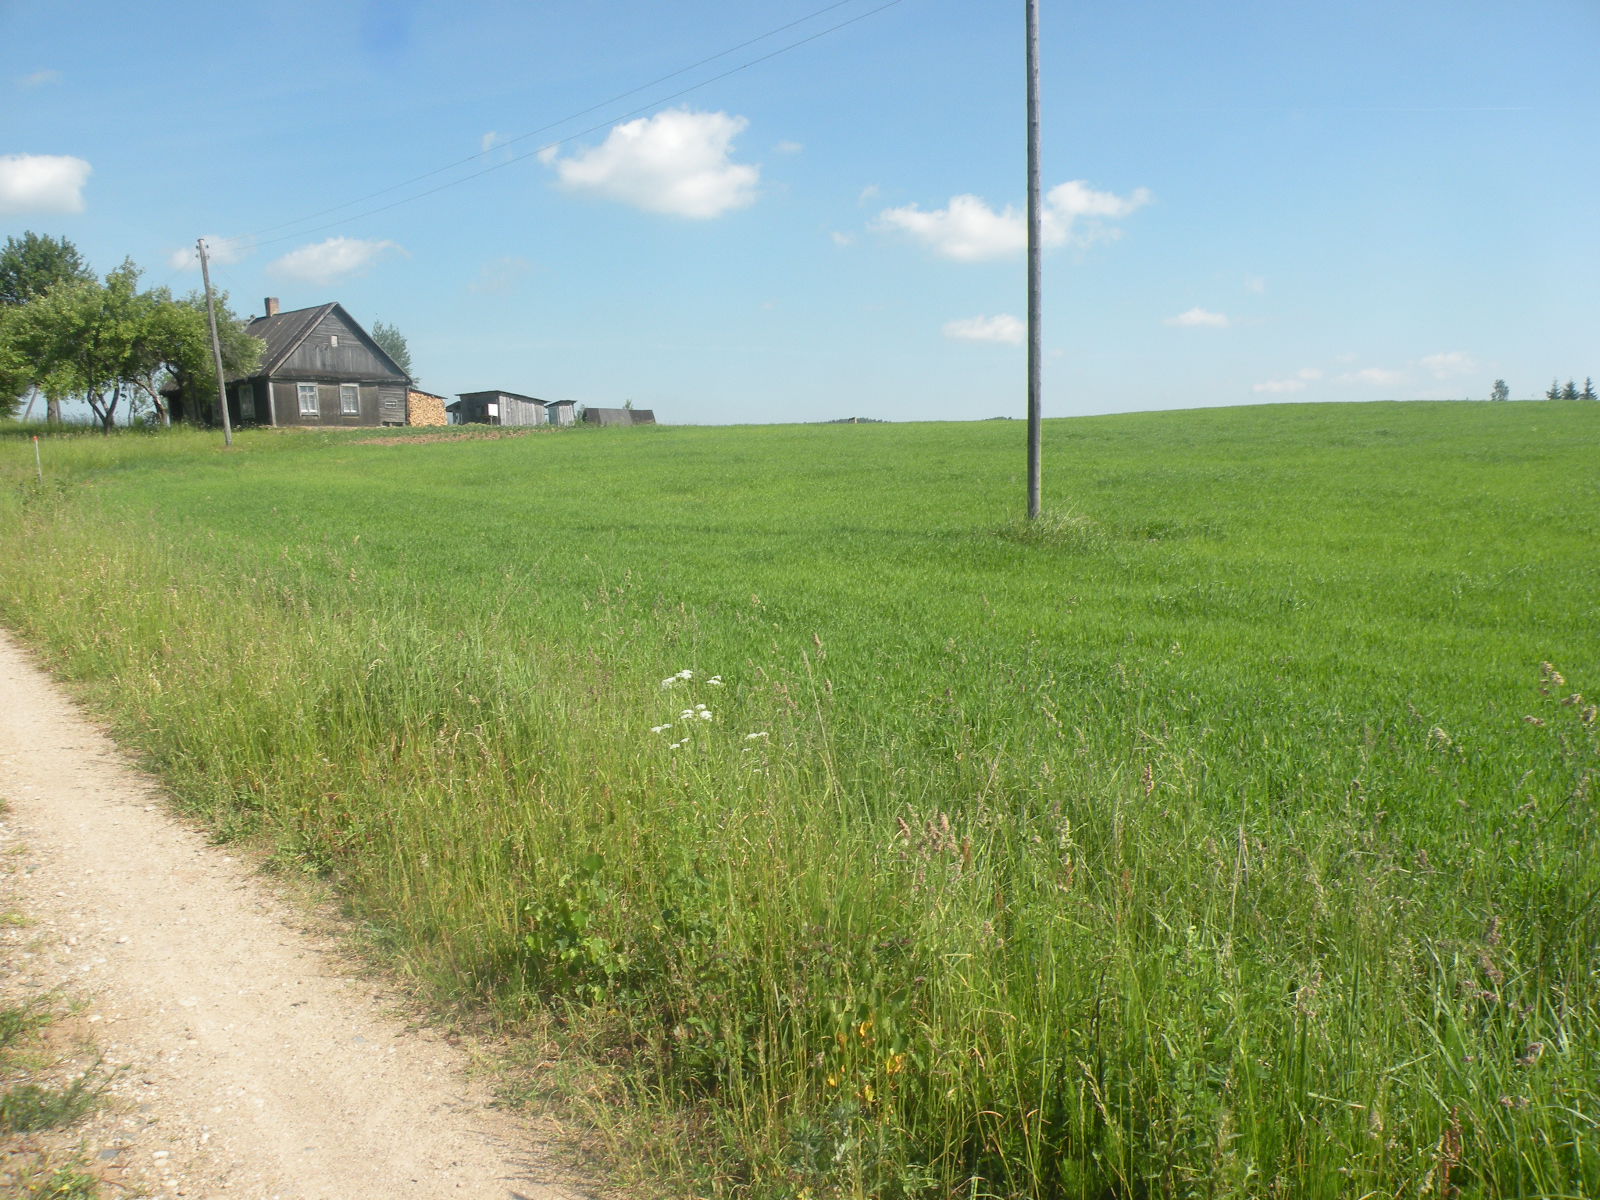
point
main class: Cropland
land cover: Barley
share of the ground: > 75 %
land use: Agriculture (excluding fallow land and kitchen gardens)
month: June
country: LV
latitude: 56.0780
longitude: 26.8211
